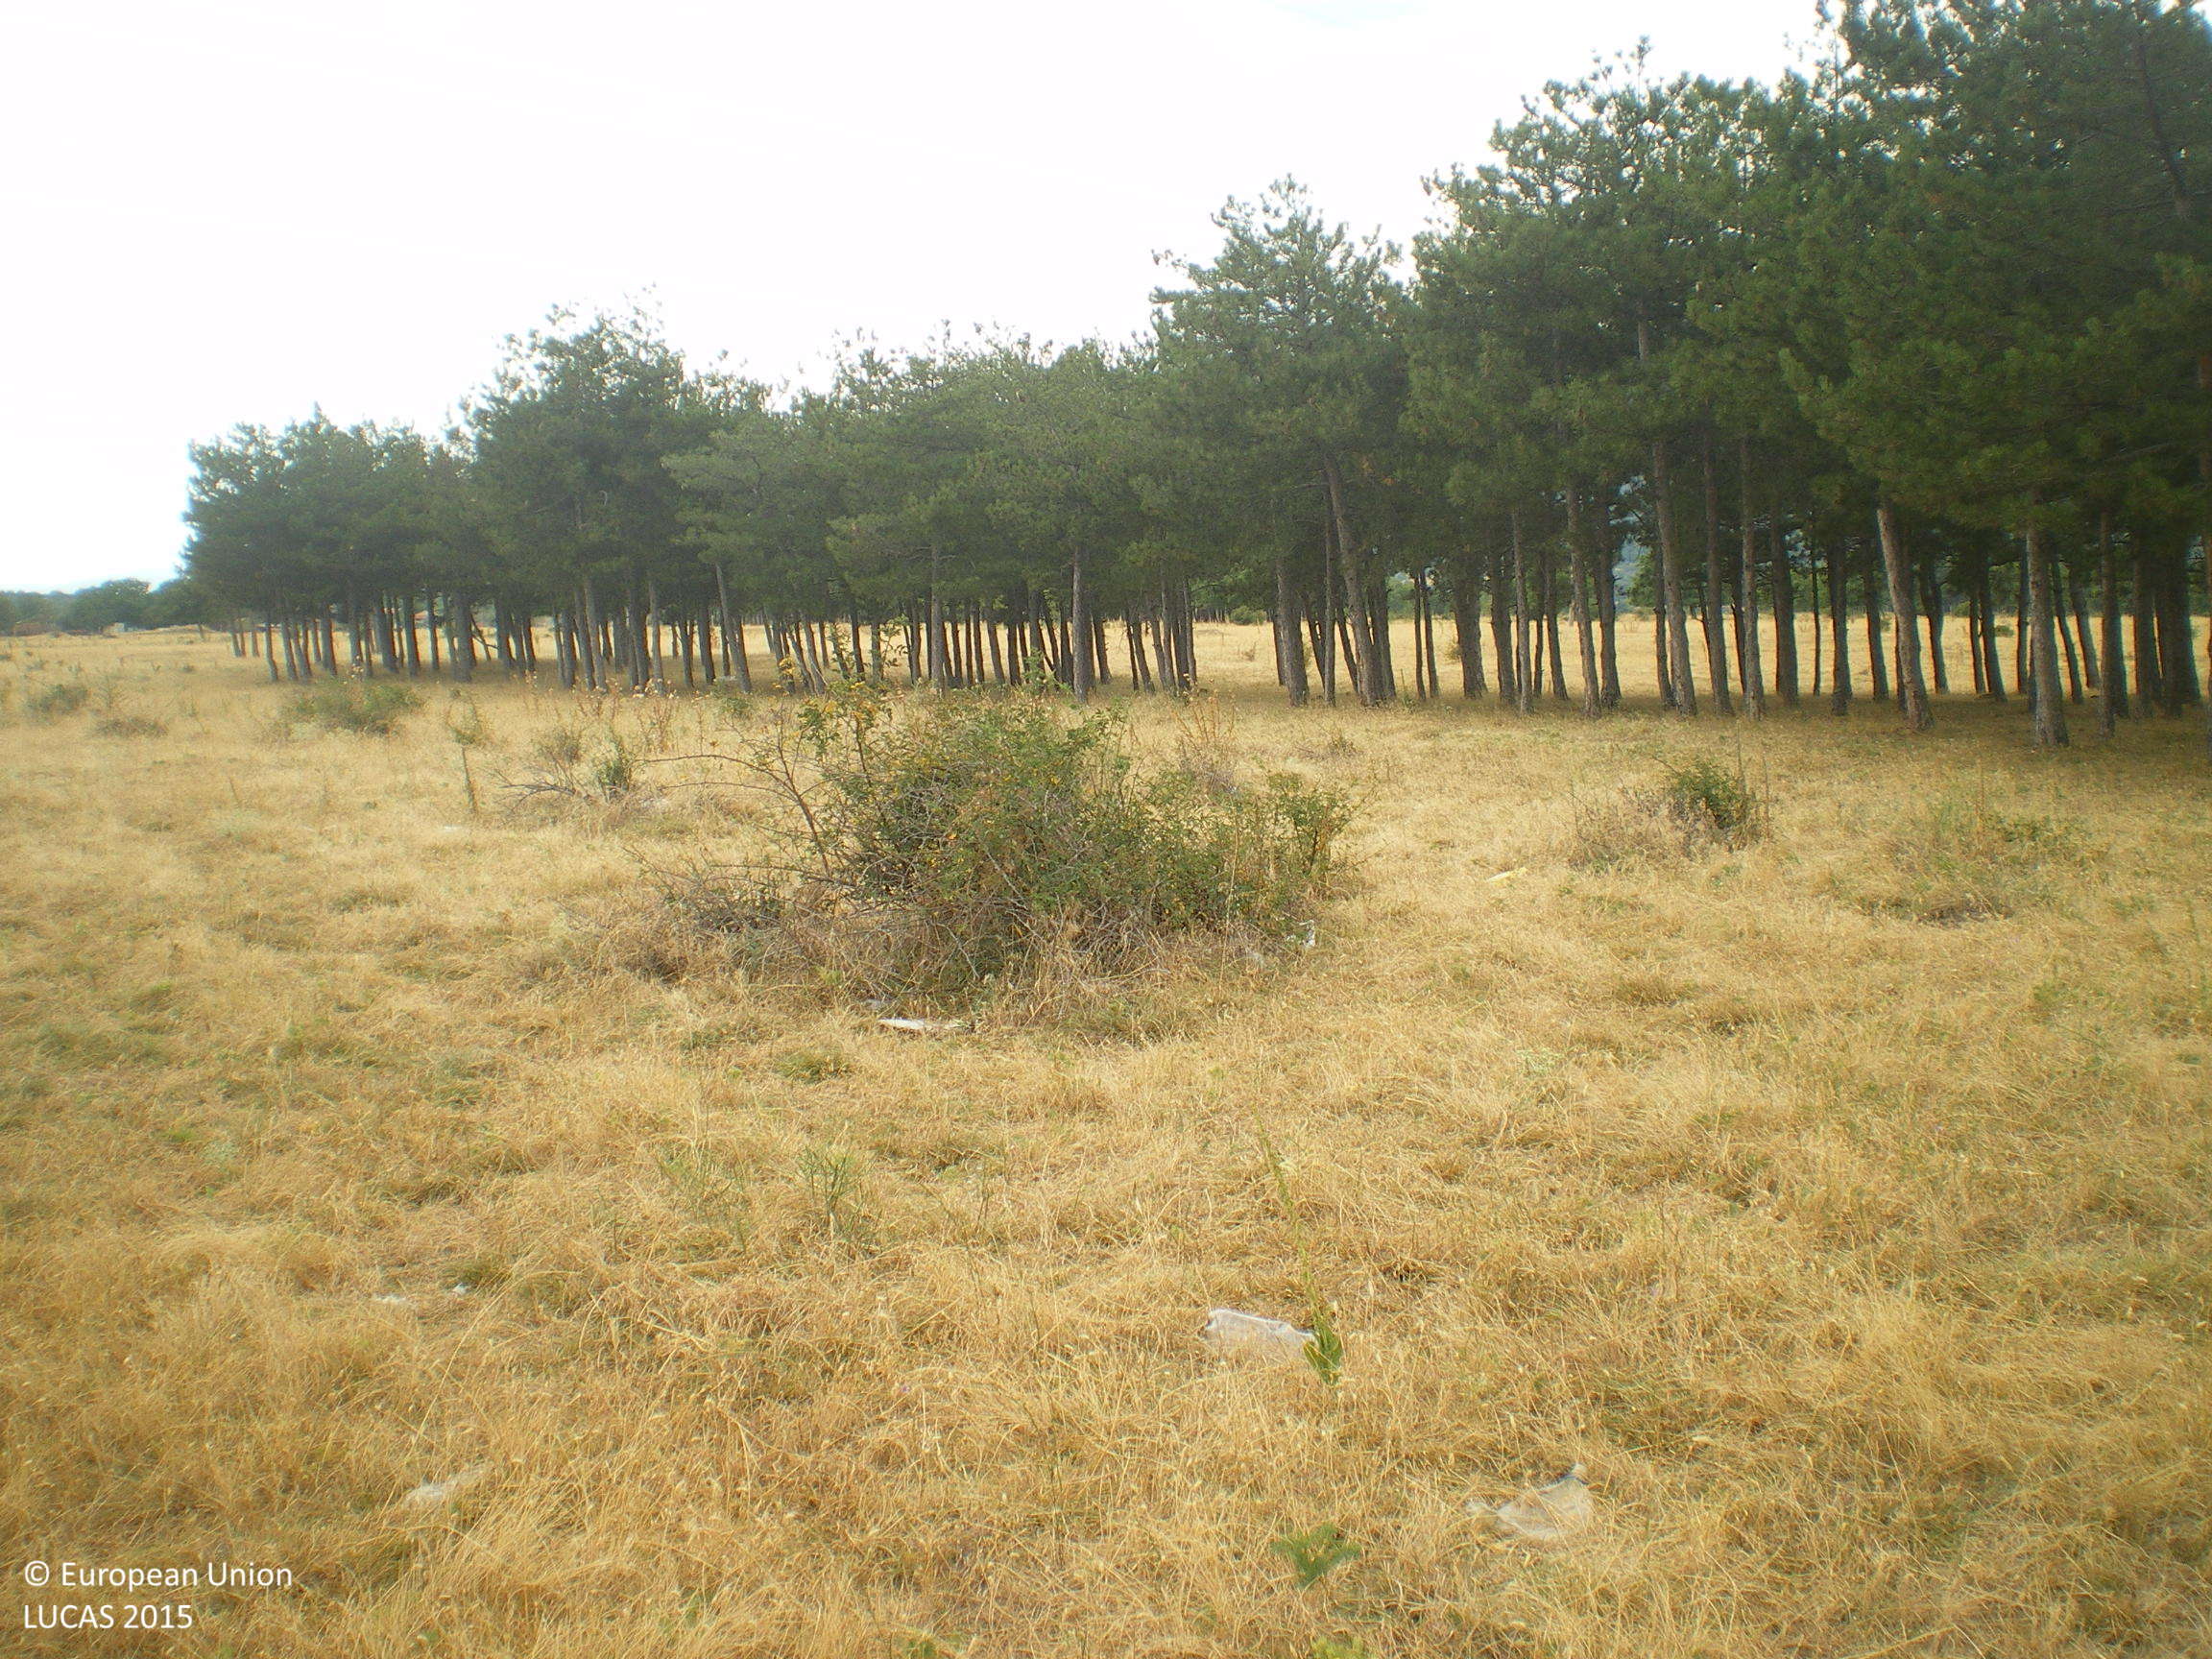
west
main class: Grassland
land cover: Grassland without tree/shrub cover
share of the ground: > 75 %
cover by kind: herbaceous plants 100 %
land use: Agriculture (excluding fallow land and kitchen gardens)
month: July
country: BG
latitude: 42.6716
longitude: 25.2089
